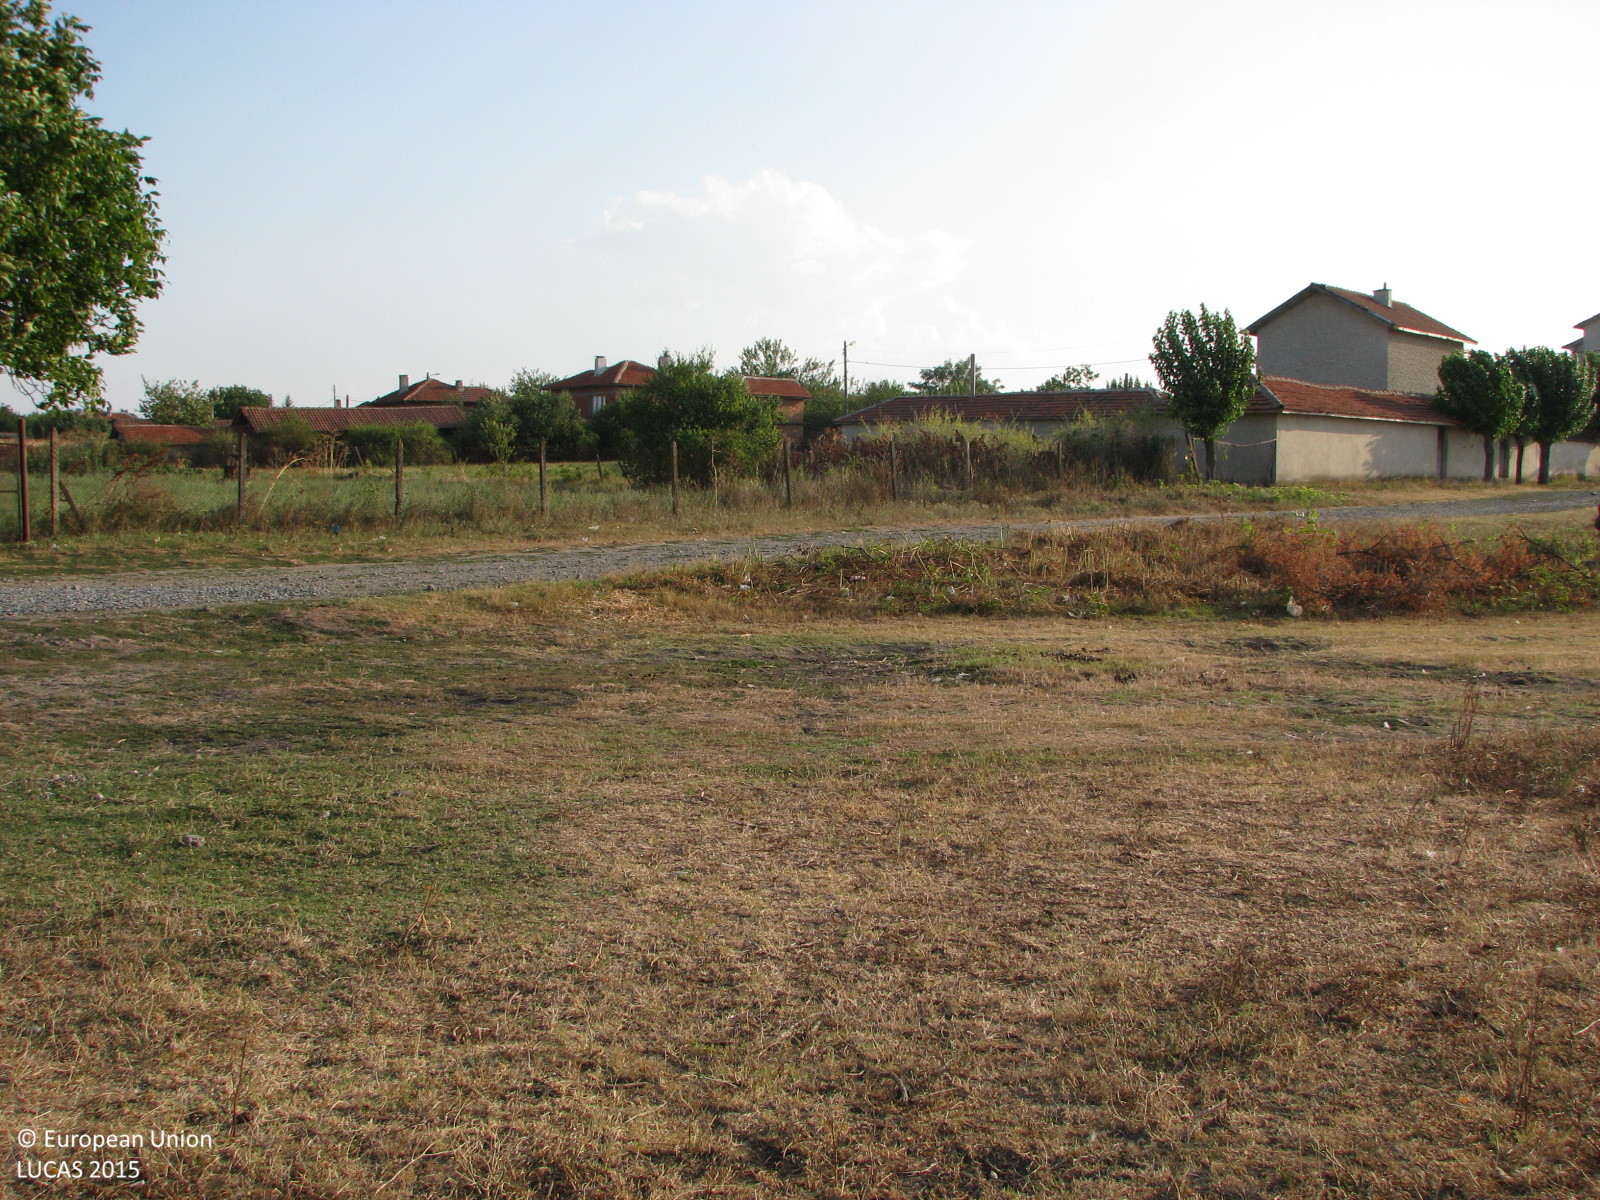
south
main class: Grassland
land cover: Grassland without tree/shrub cover
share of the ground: > 75 %
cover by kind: herbaceous plants 100 %
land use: Residential
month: August
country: BG
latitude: 42.5138
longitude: 26.6614
